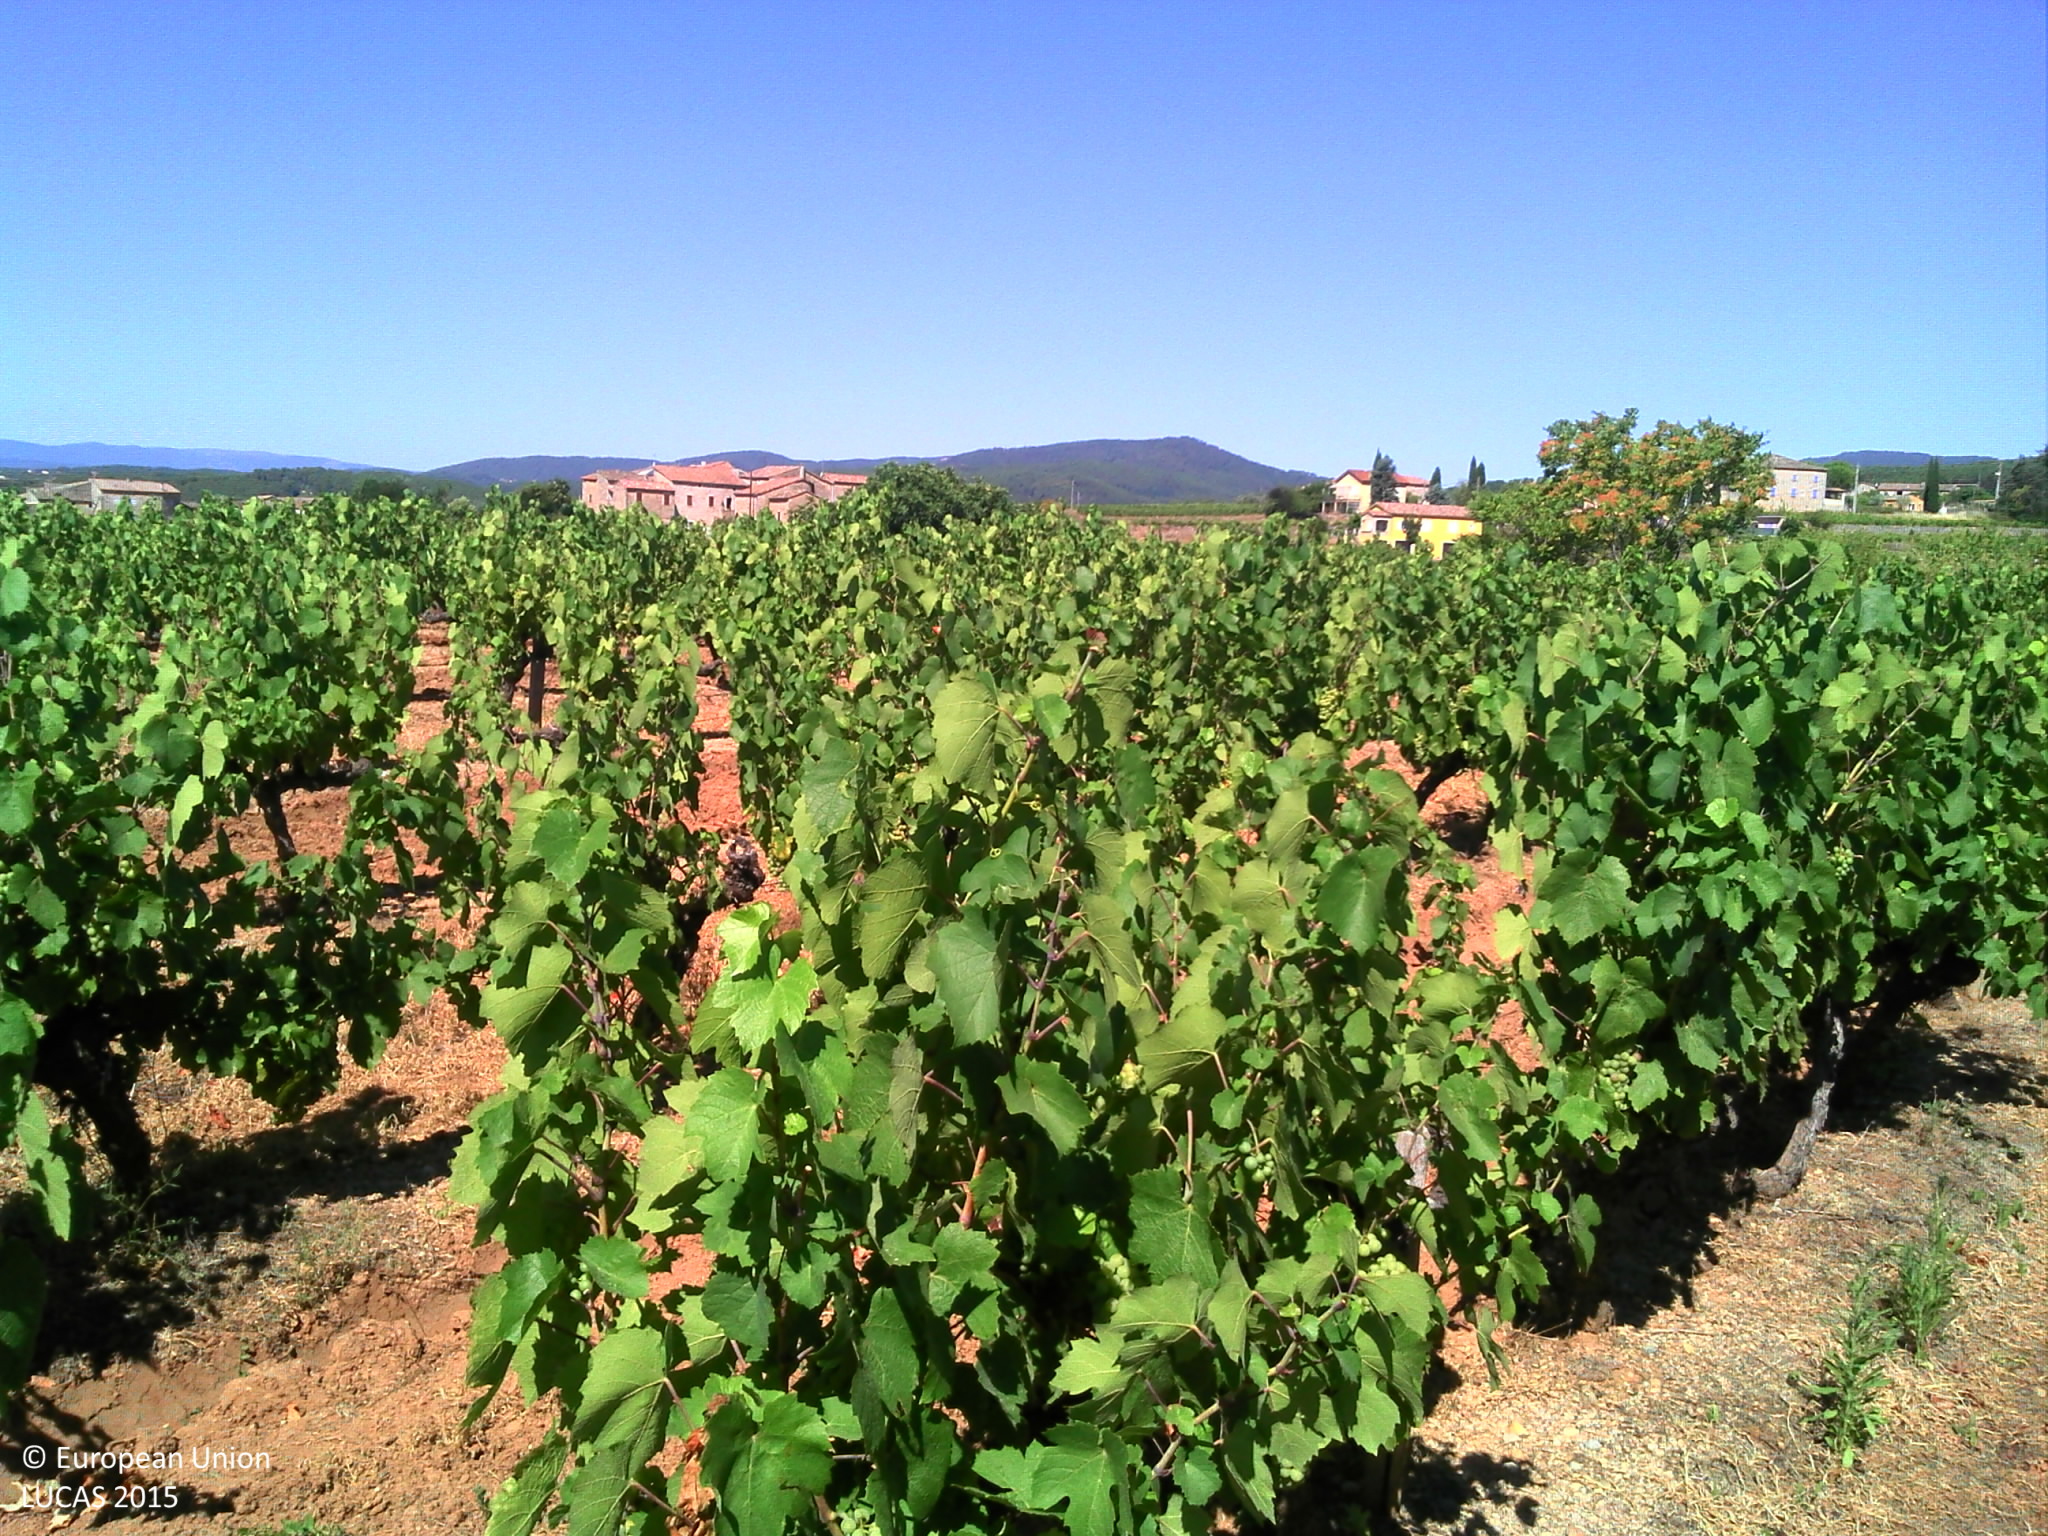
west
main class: Cropland
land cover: Vineyards
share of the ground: 25 - 50 %
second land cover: Other bare soil
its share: > 75 %
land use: Agriculture (excluding fallow land and kitchen gardens)
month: July
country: FR
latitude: 44.4989
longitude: 4.2589
